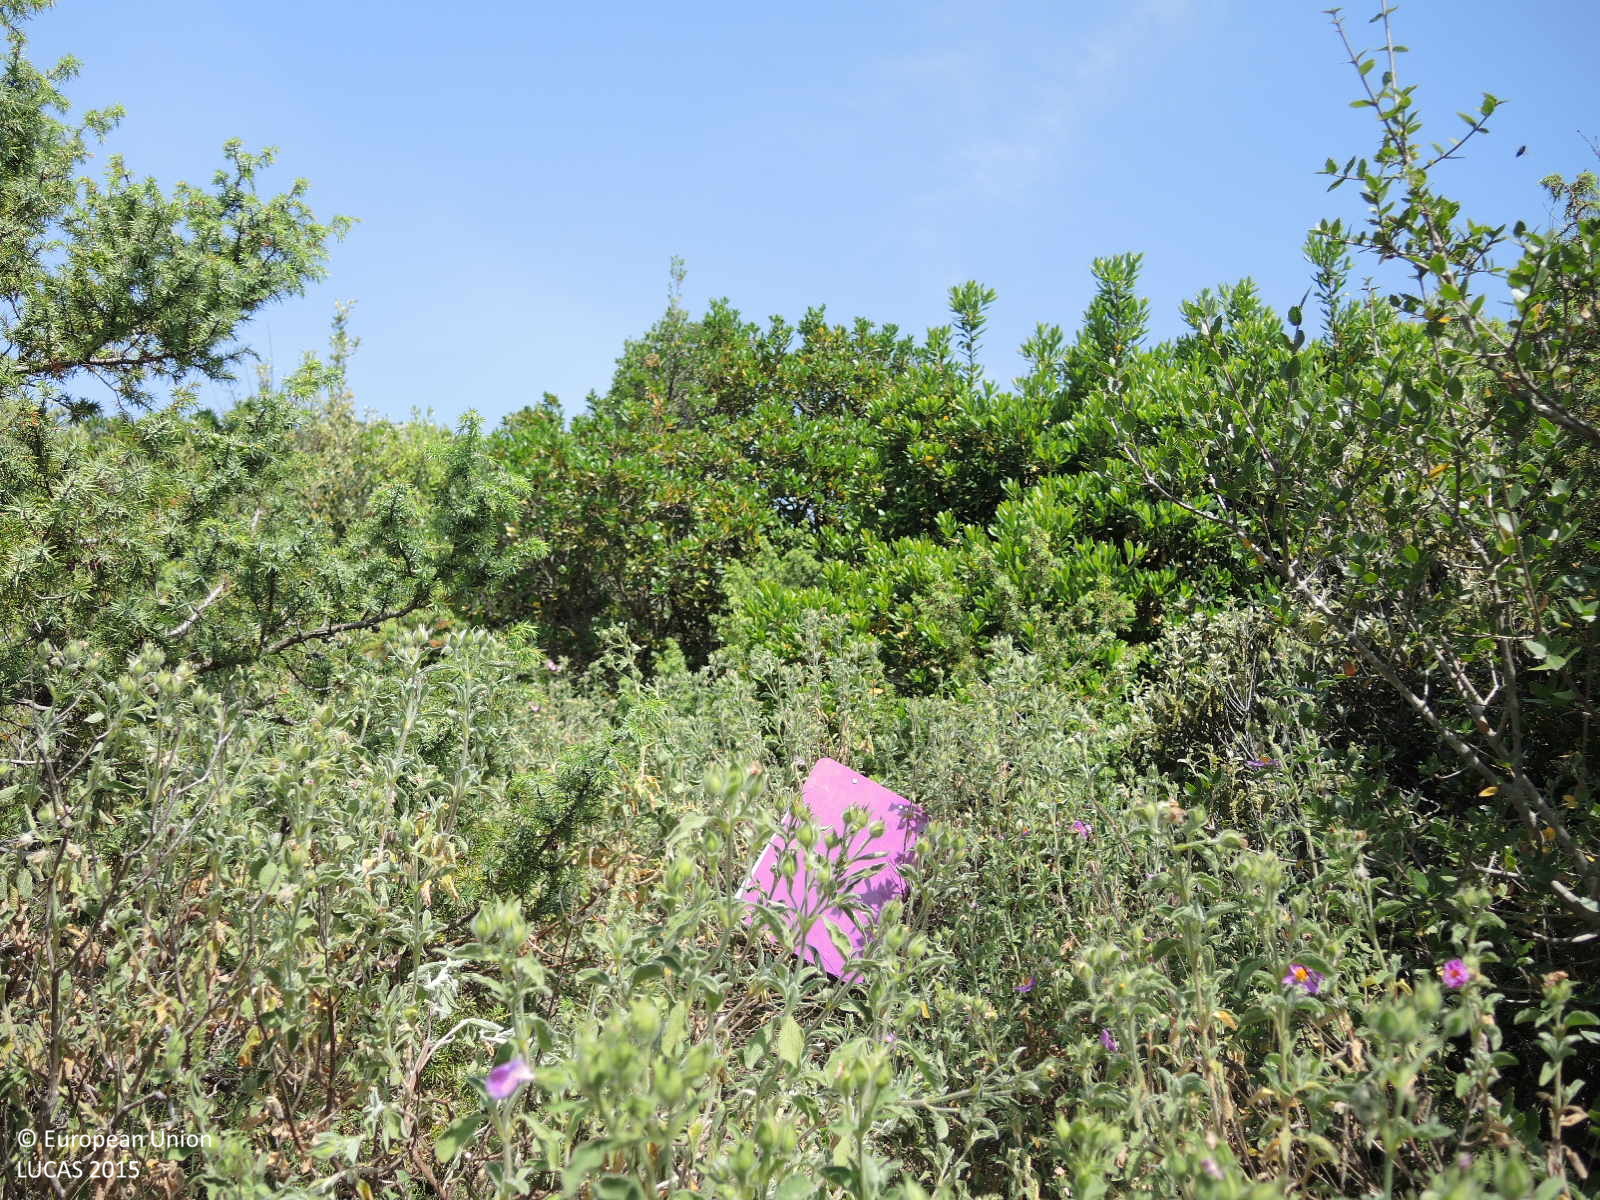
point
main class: Shrubland
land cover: Shrubland without tree cover
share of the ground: > 75 %
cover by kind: shrubs 70 %, herbaceous plants 20 %, unconsolidated bare surface 10 %
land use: Semi-natural and natural areas not in use
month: May
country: HR
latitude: 43.8503
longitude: 15.7011
